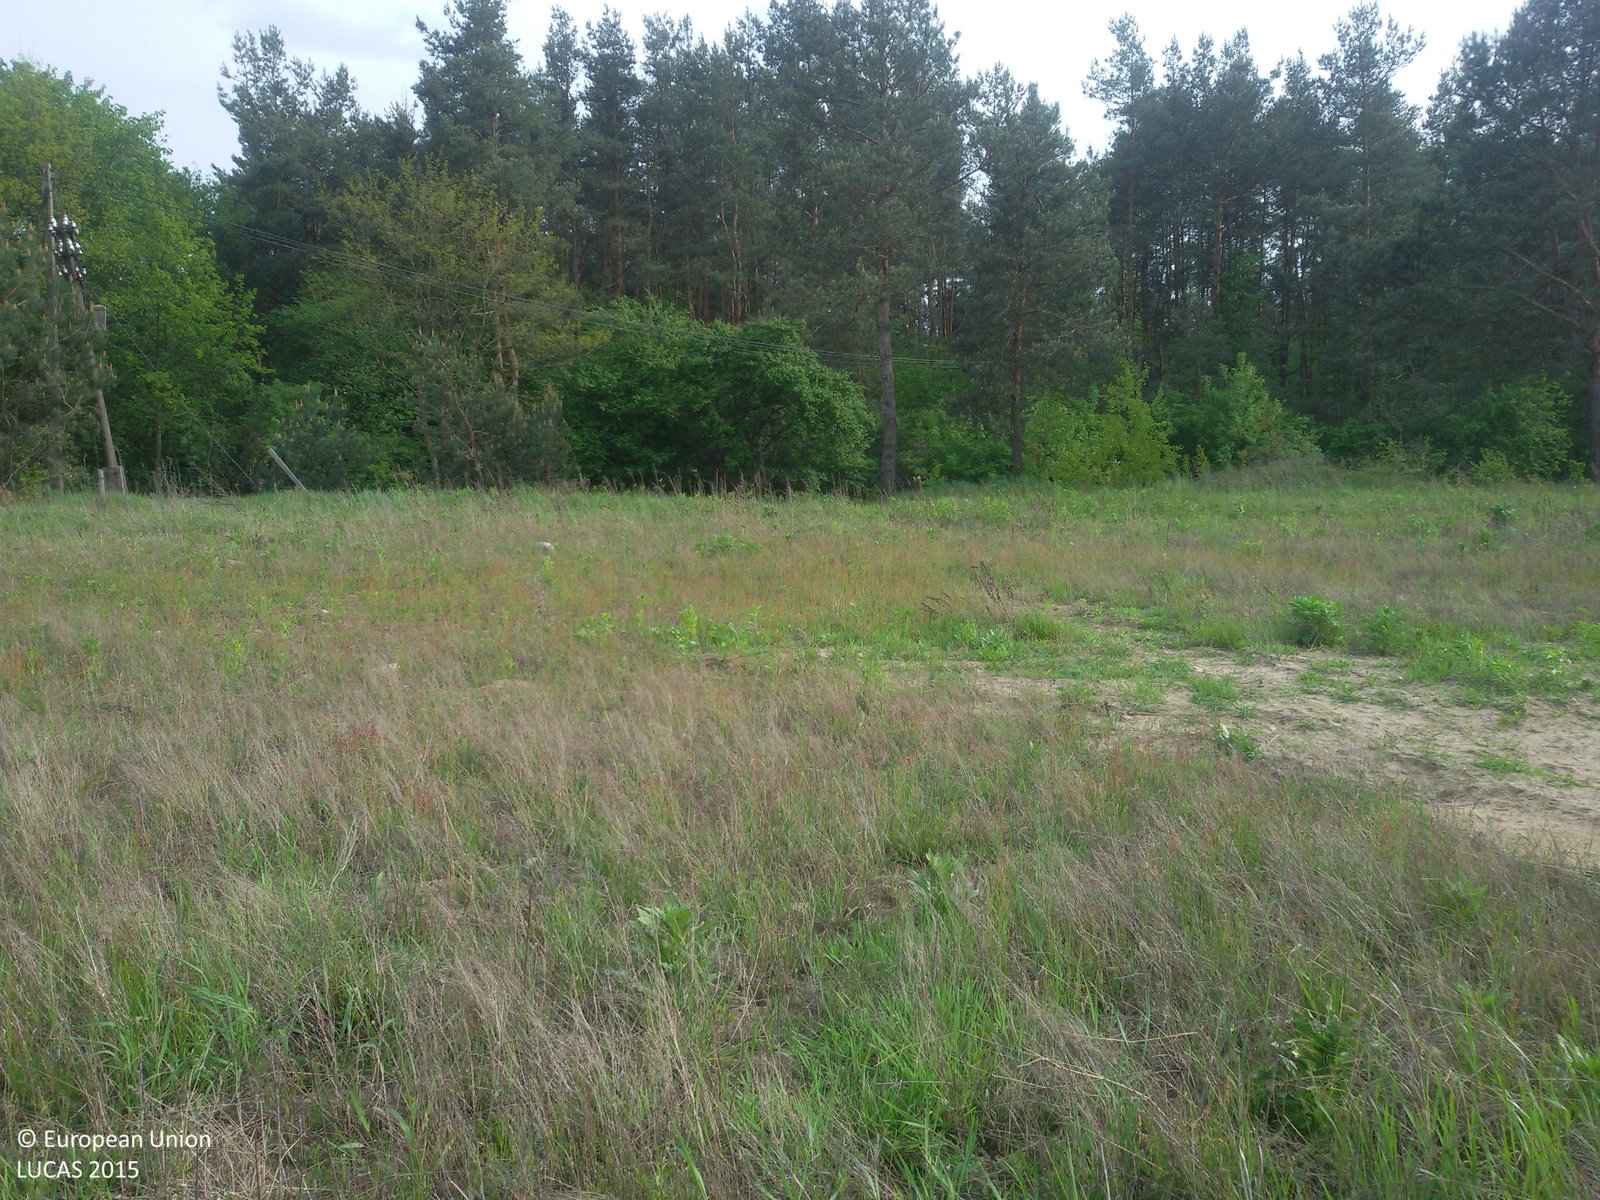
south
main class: Grassland
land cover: Spontaneously vegetated surfaces
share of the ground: > 75 %
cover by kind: herbaceous plants 90 %
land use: Semi-natural and natural areas not in use
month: May
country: PL
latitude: 51.9766
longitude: 20.7709
